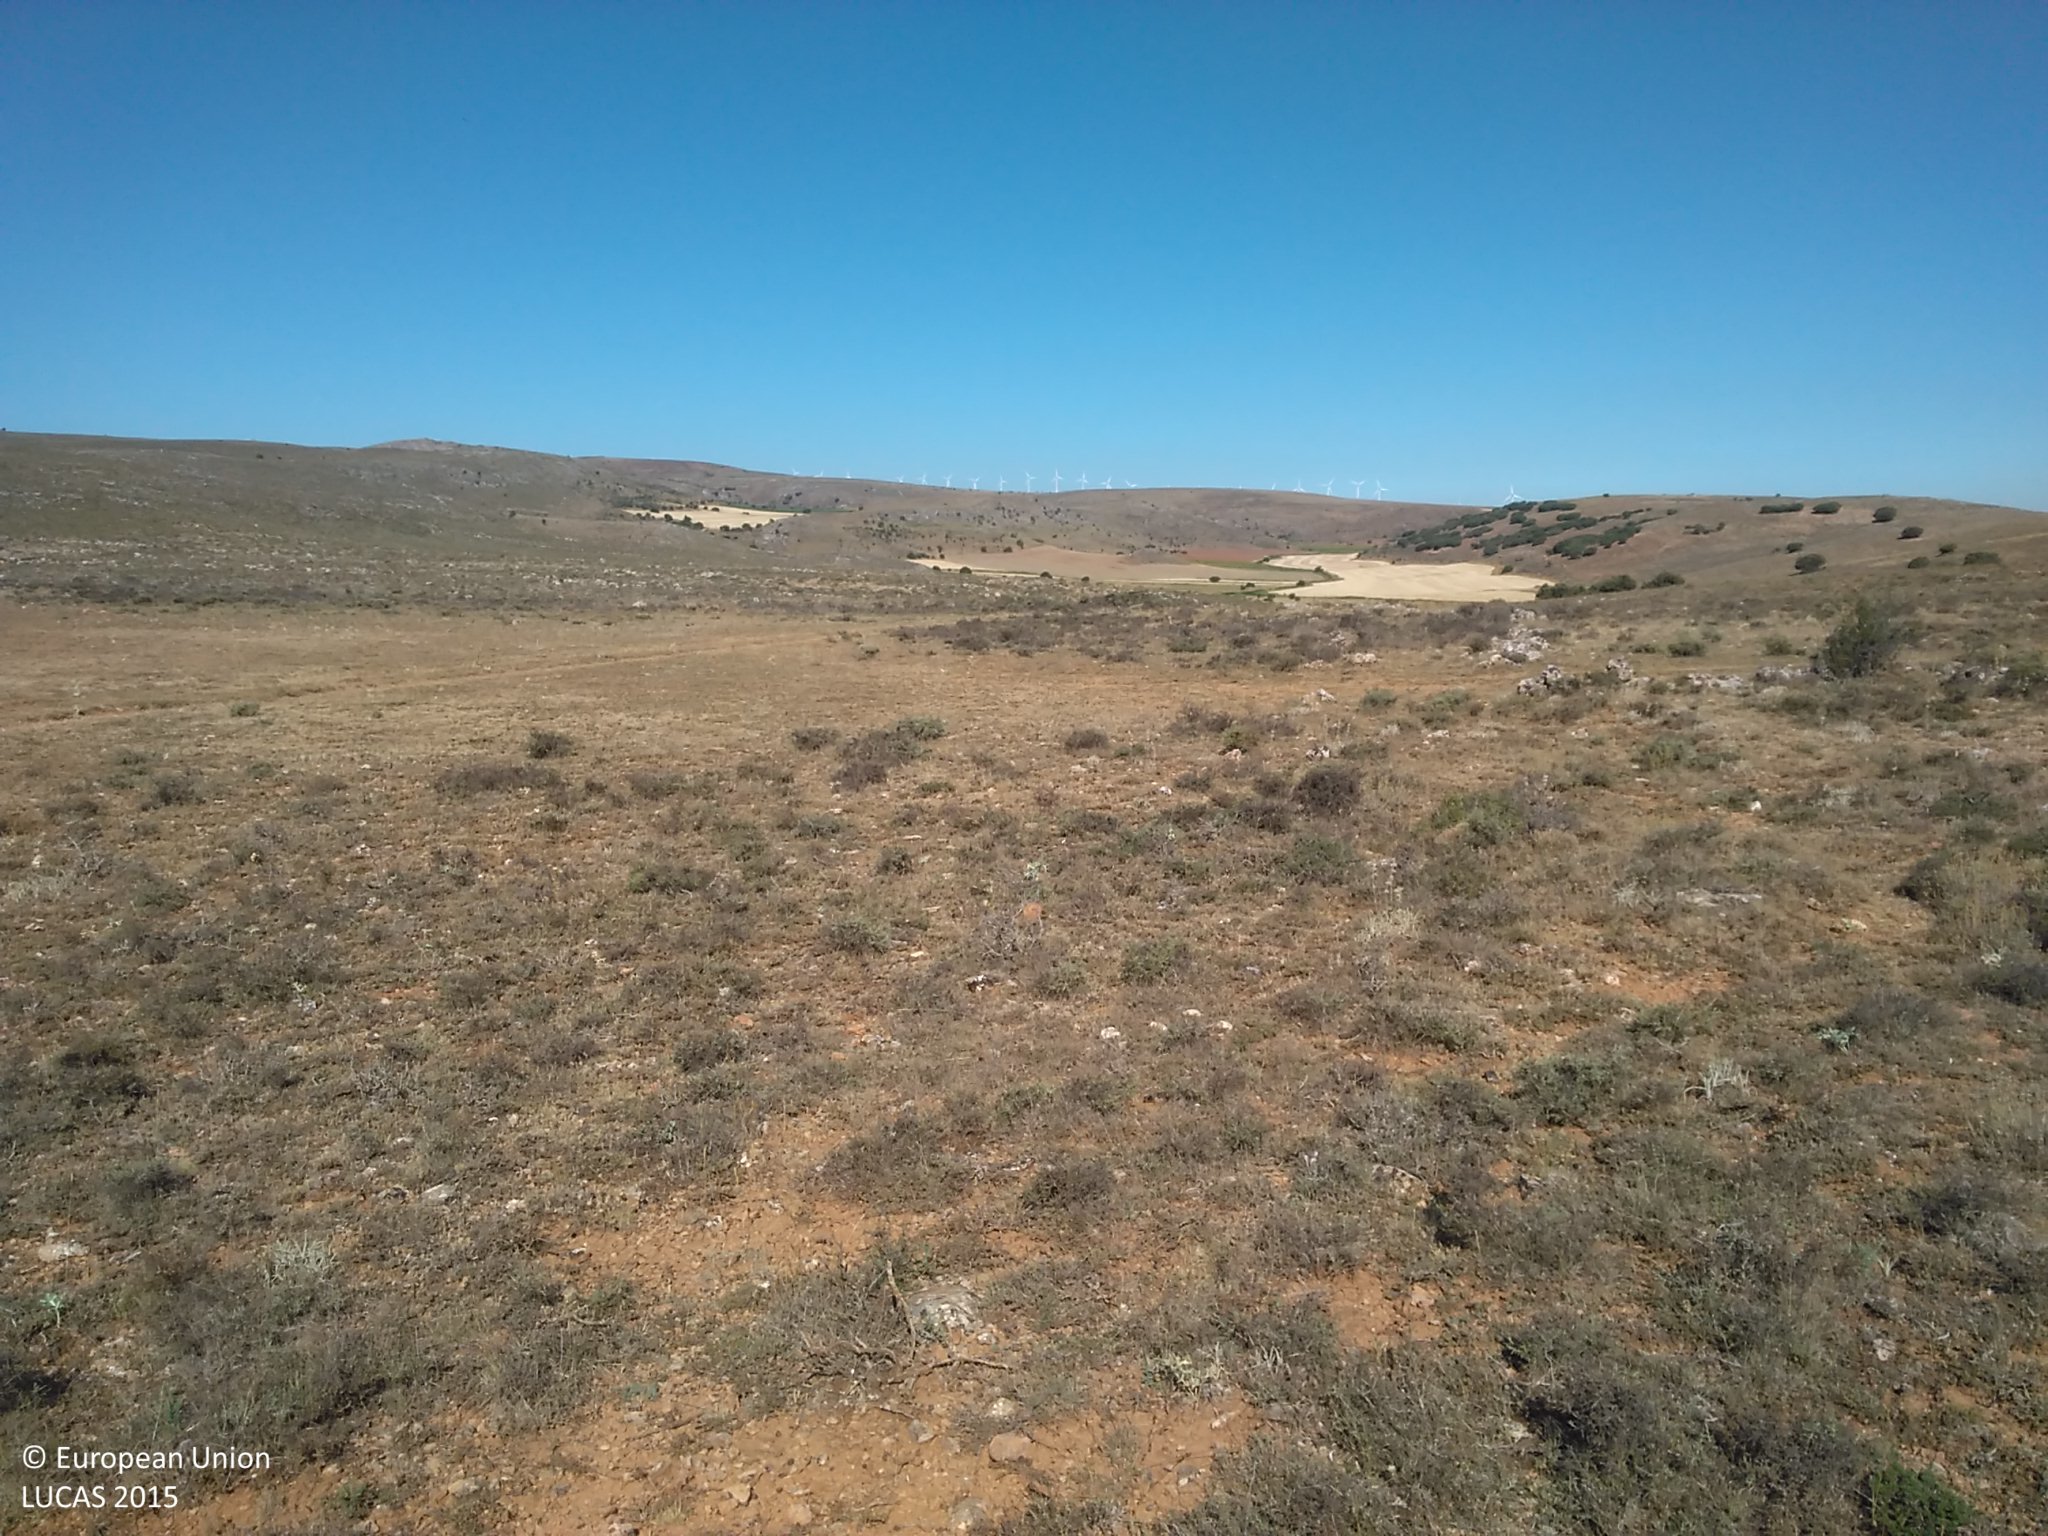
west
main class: Shrubland
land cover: Shrubland without tree cover
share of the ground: 50 - 75 %
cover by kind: shrubs 60 %, unconsolidated bare surface 40 %
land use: Semi-natural and natural areas not in use
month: July
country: ES
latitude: 41.2893
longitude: -2.9465
